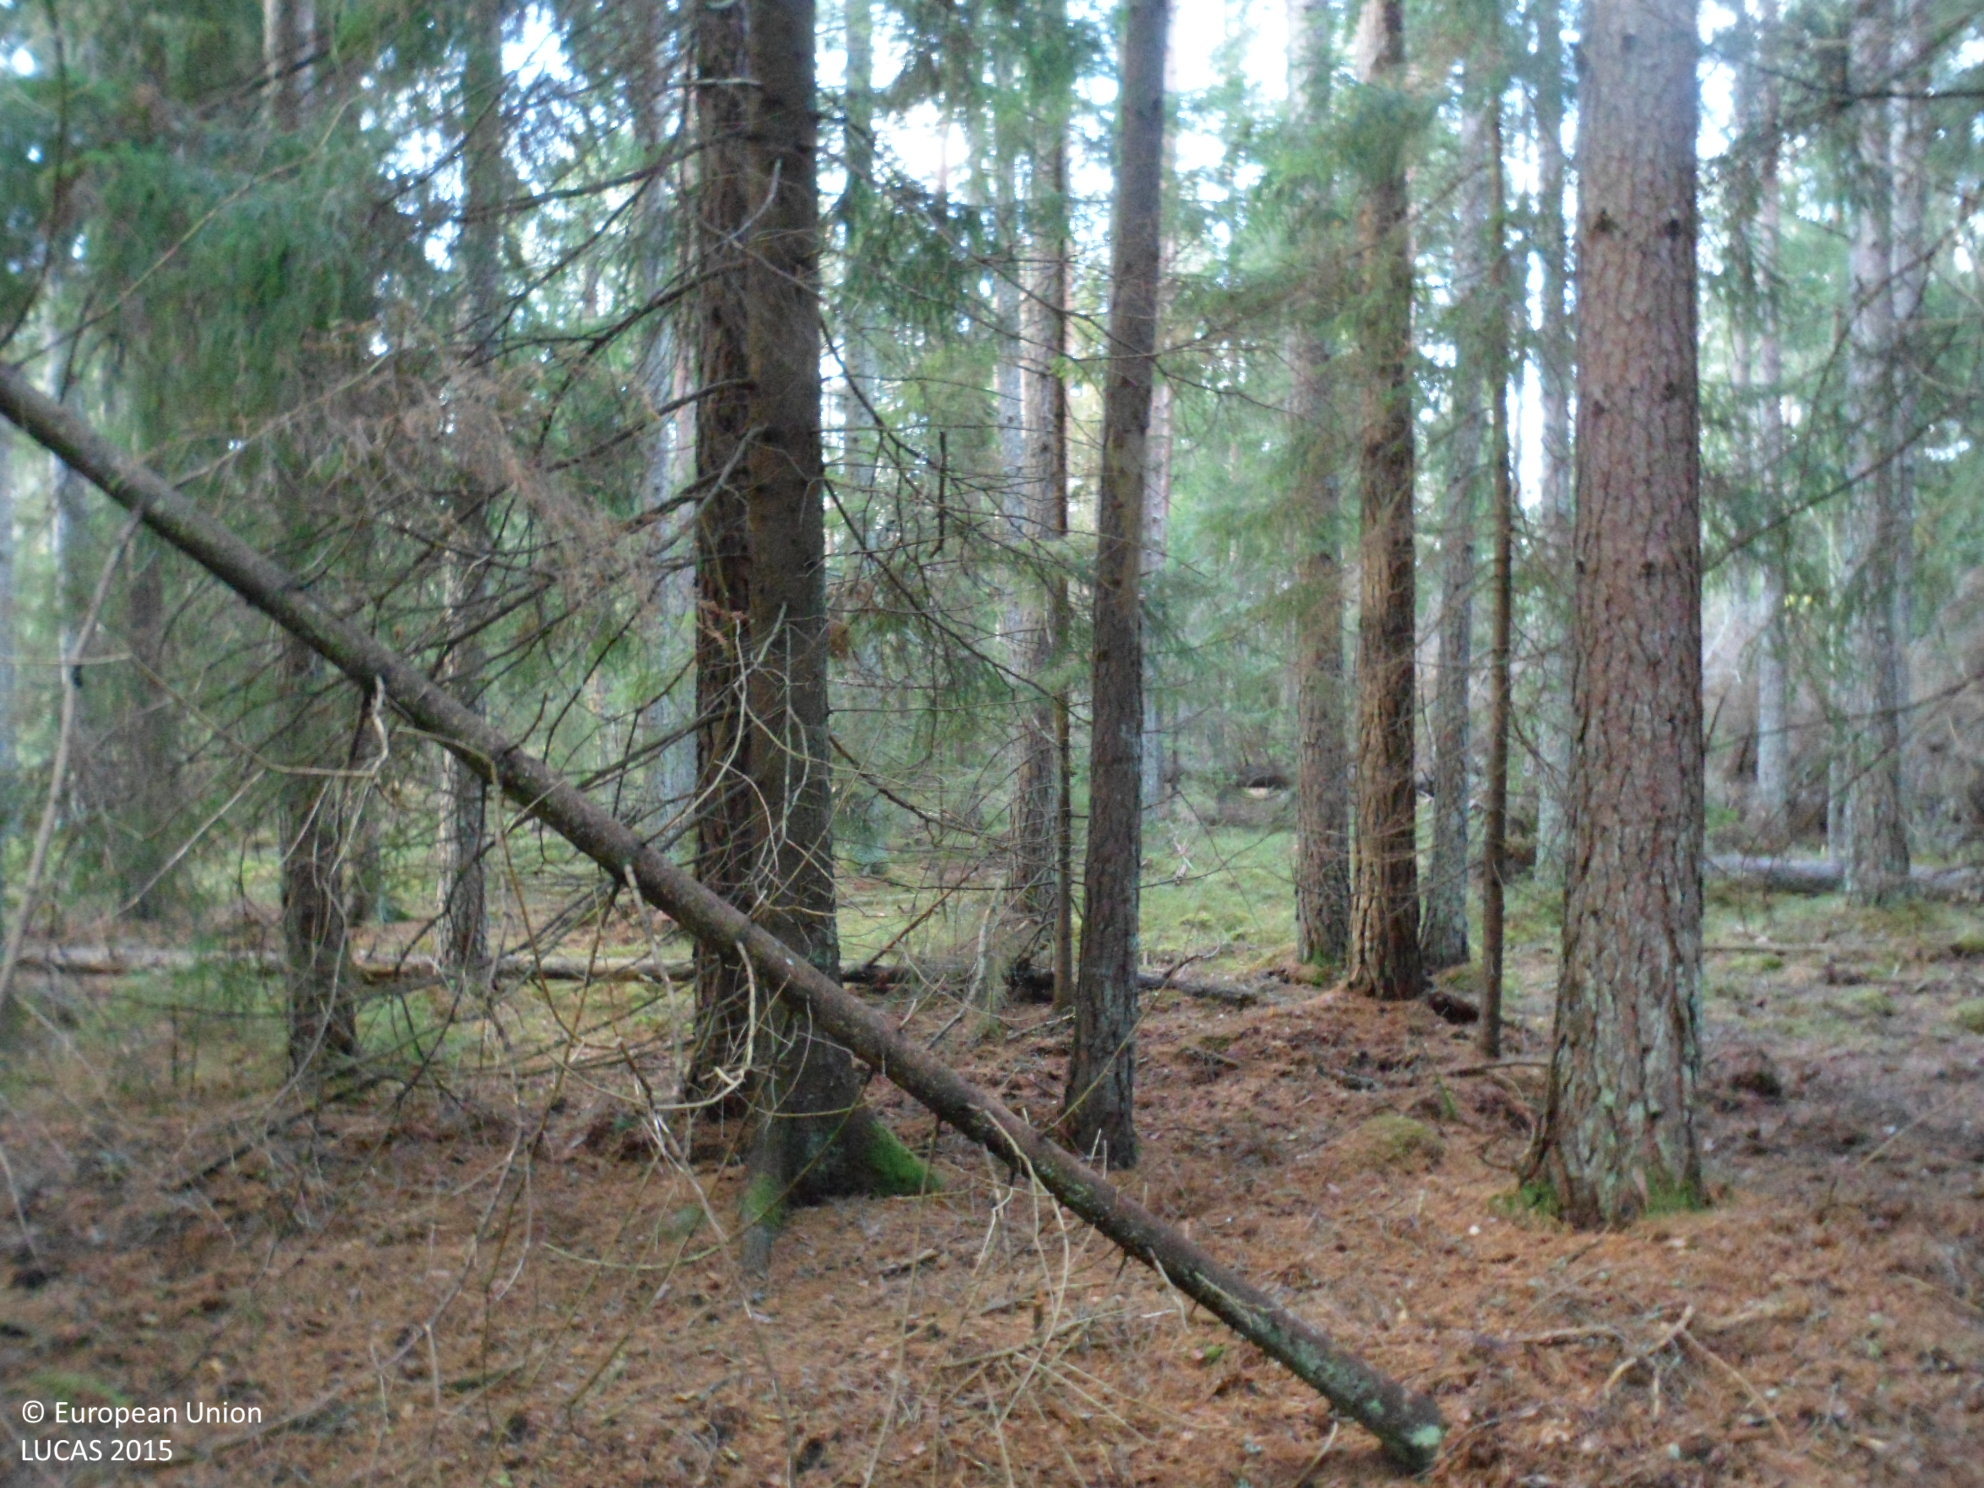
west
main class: Woodland
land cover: Other coniferous woodland
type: boreal forest
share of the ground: 50 - 75 %
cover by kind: coniferous forest trees 60 %, lichens and mosses 20 %, shrubs 15 %, unconsolidated bare surface 5 %
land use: Forestry
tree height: > 5 m
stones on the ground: 10 - 25 %
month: November
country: SE
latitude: 56.9118
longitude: 16.0269
